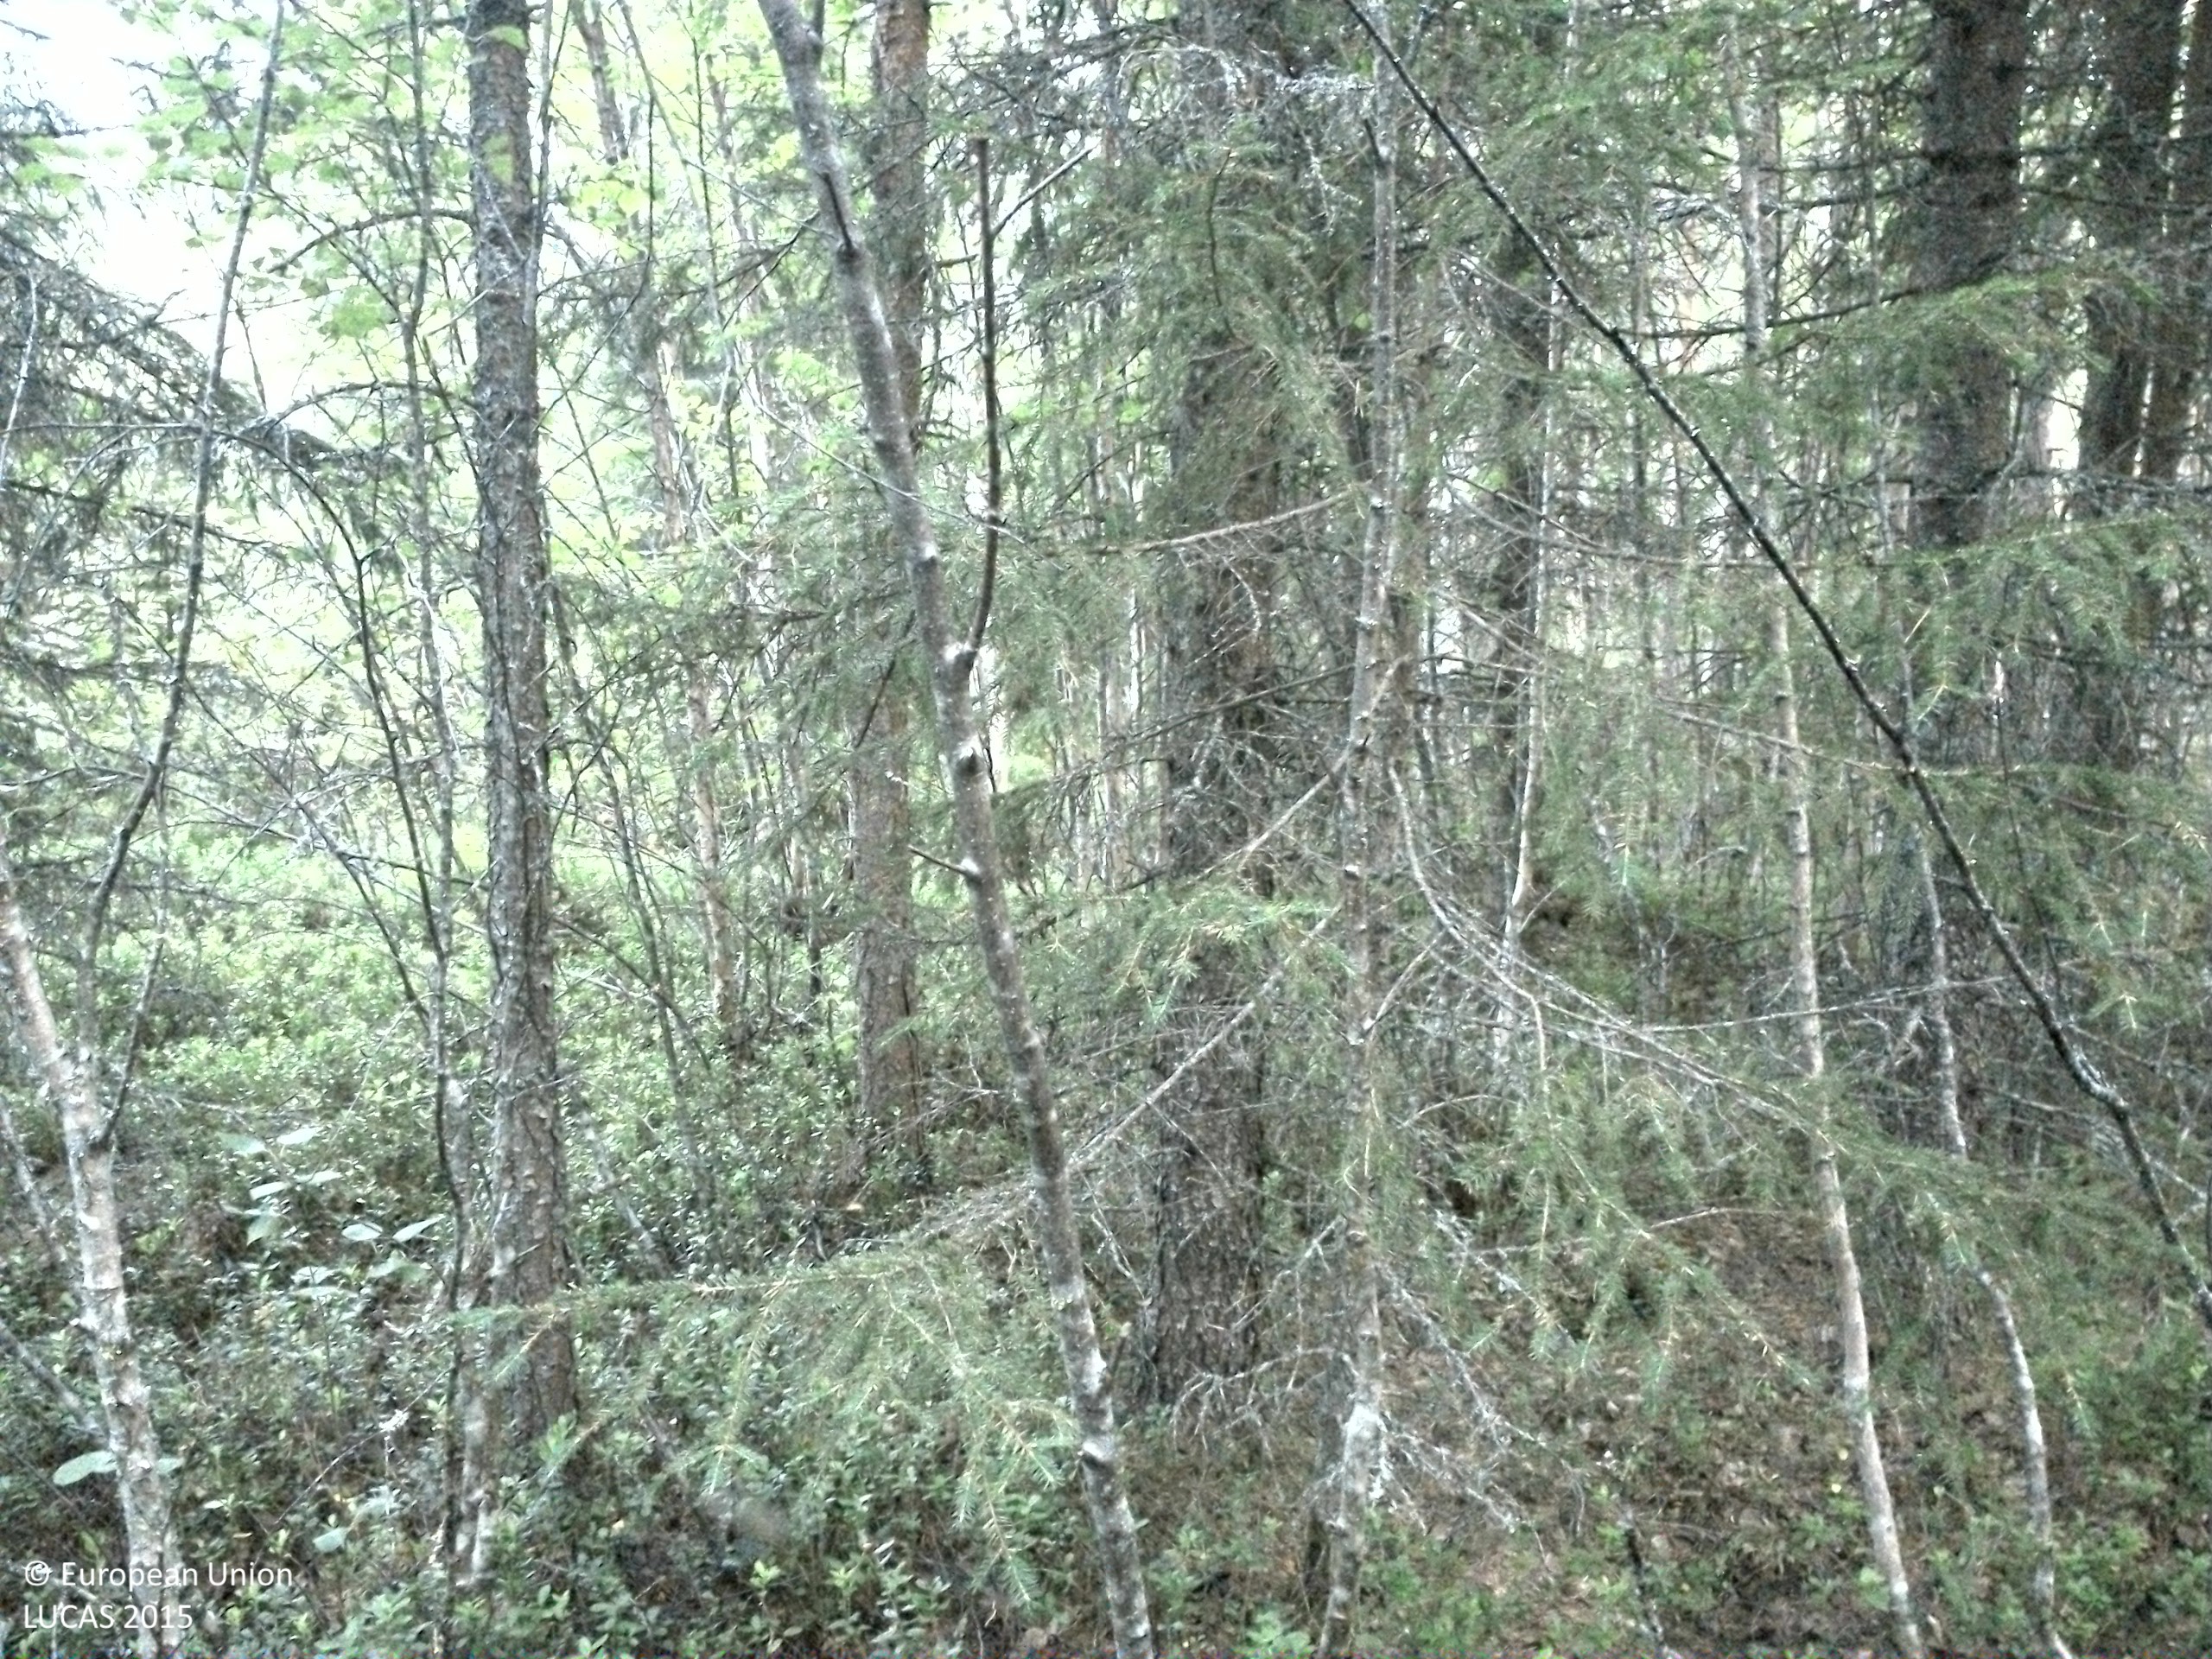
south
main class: Woodland
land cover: Other mixed woodland
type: boreal forest
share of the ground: > 75 %
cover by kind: broadleaved forest trees 50 %, coniferous forest trees 30 %, shrubs 10 %, lichens and mosses 10 %
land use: Forestry
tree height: > 5 m
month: August
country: SE
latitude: 63.6328
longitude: 16.4513
